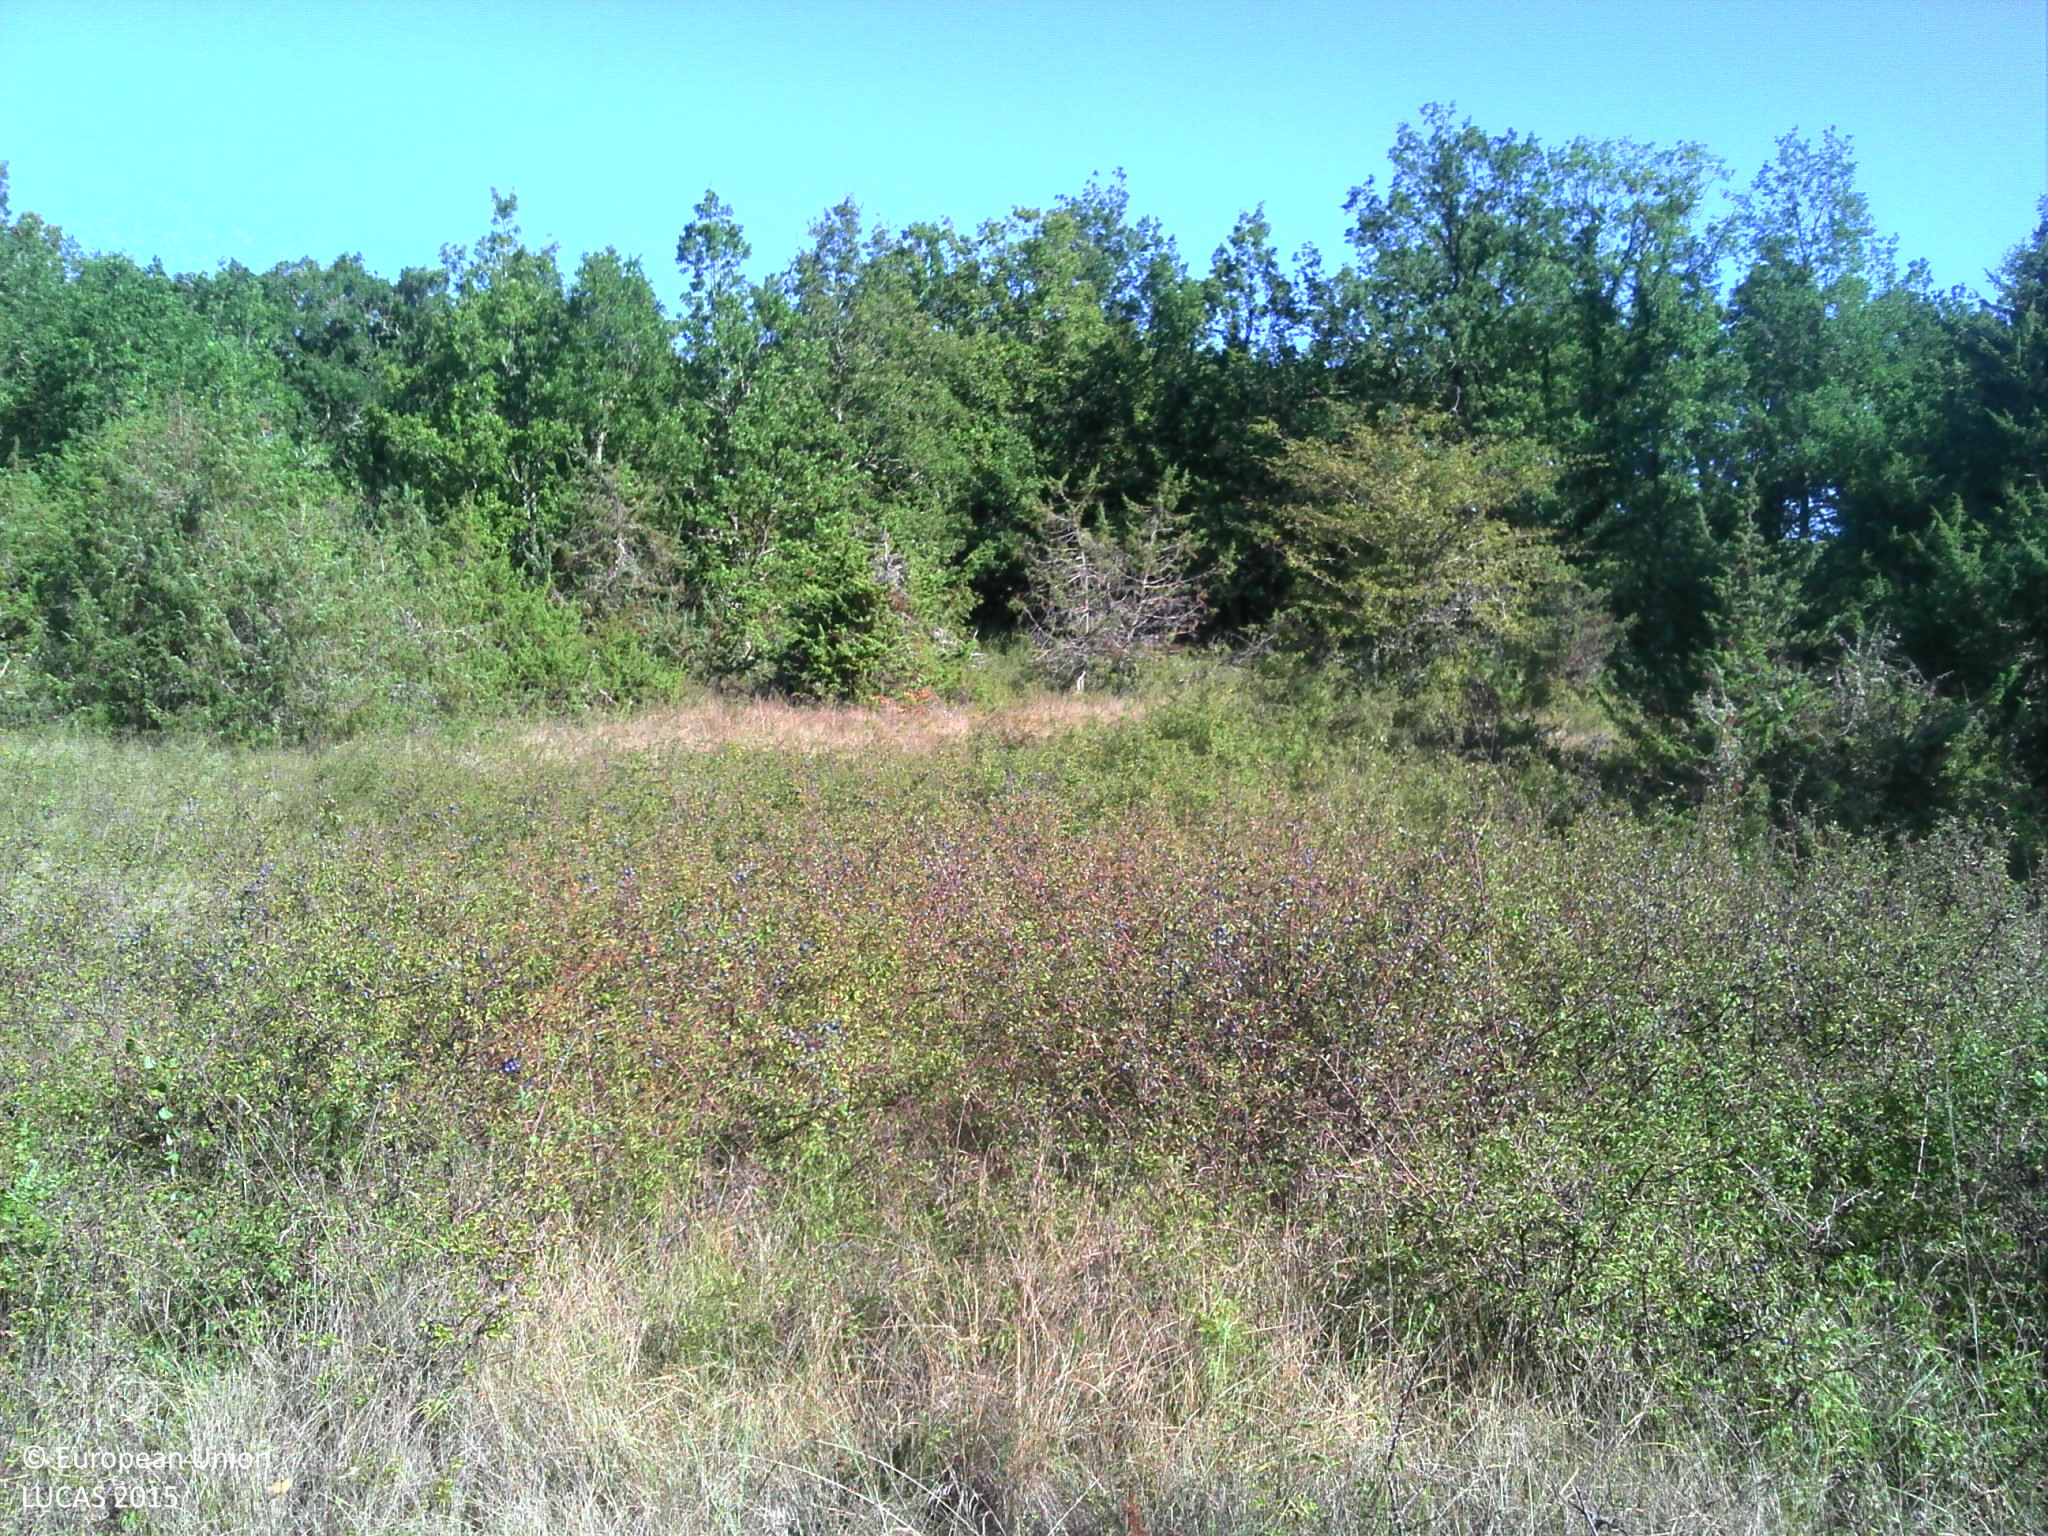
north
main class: Grassland
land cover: Grassland with sparse tree/shrub cover
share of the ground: > 75 %
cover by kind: herbaceous plants 85 %, shrubs 10 %, broadleaved forest trees 5 %
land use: Agriculture (excluding fallow land and kitchen gardens)
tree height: > 5 m
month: August
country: FR
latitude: 44.3564
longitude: 1.6312
